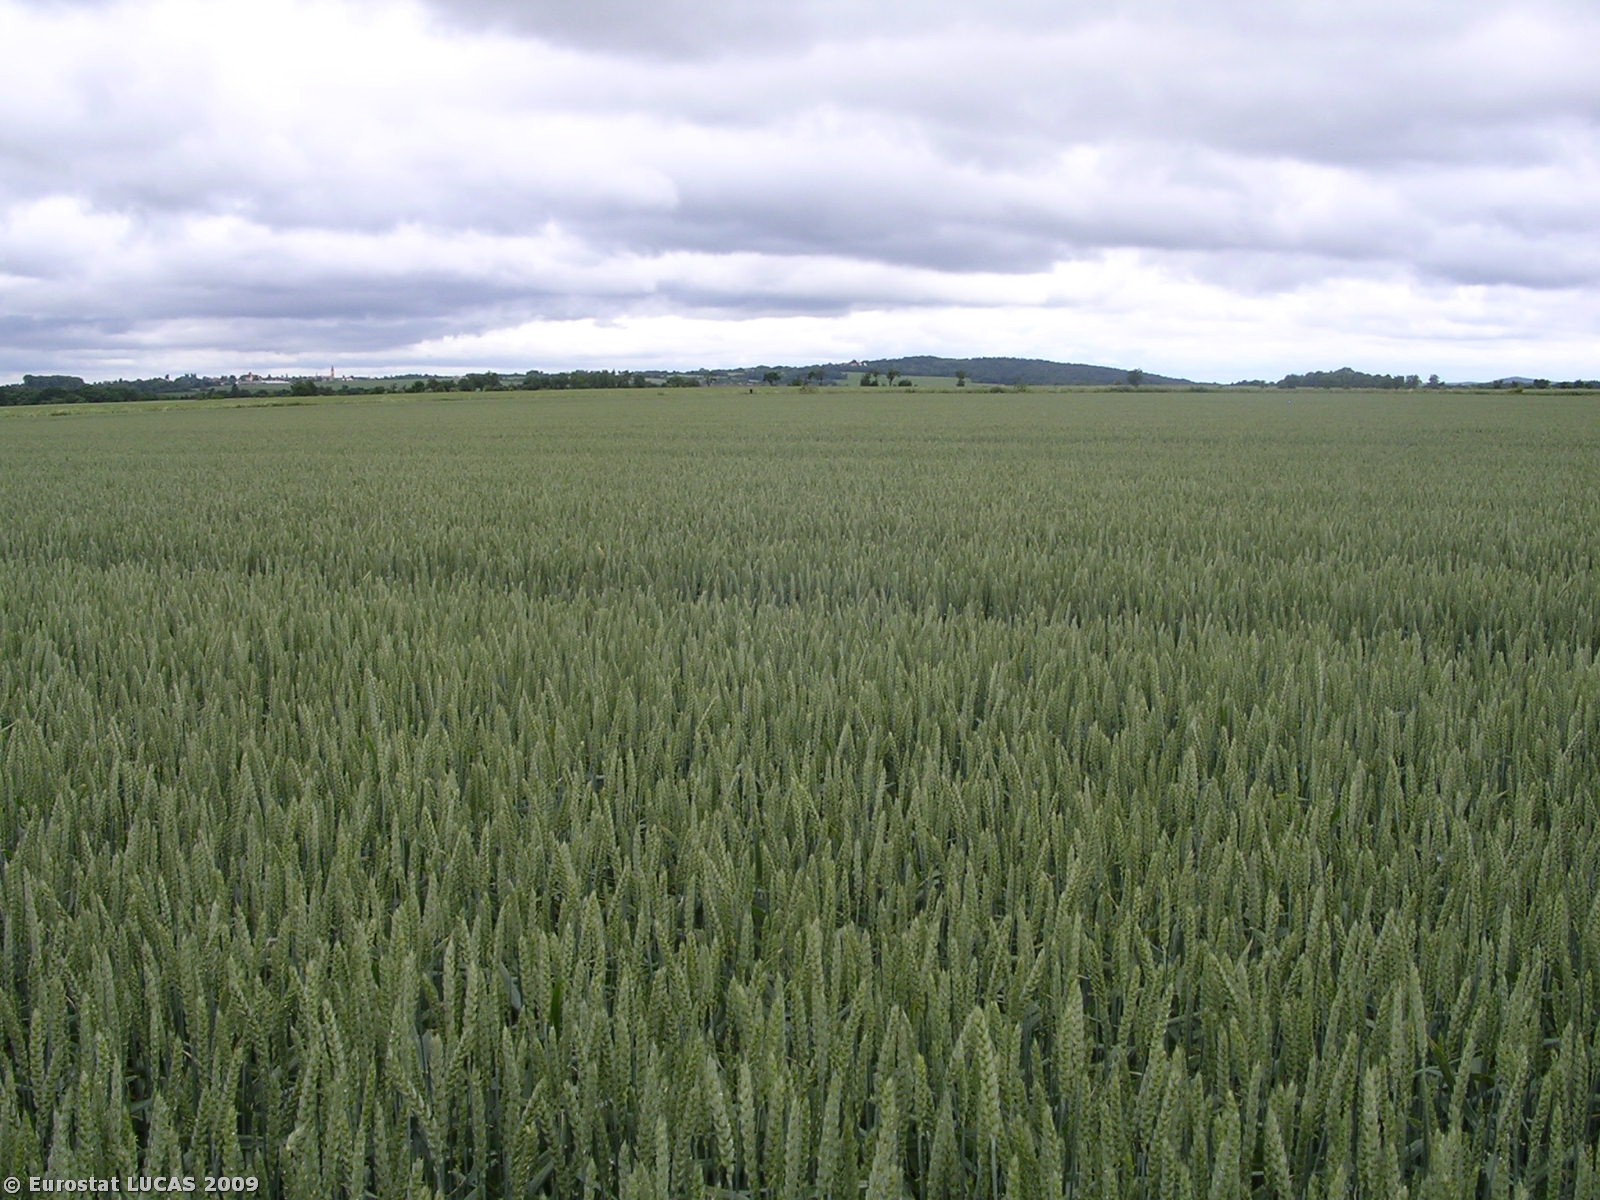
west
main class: Woodland
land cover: Coniferous woodland
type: hemiboreal forest and nemoral coniferous forest and mixed broadleaved-coniferous forest
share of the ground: > 75 %
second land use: Forestry
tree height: > 5 m
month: June
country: CZ
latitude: 50.5294
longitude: 14.8978
